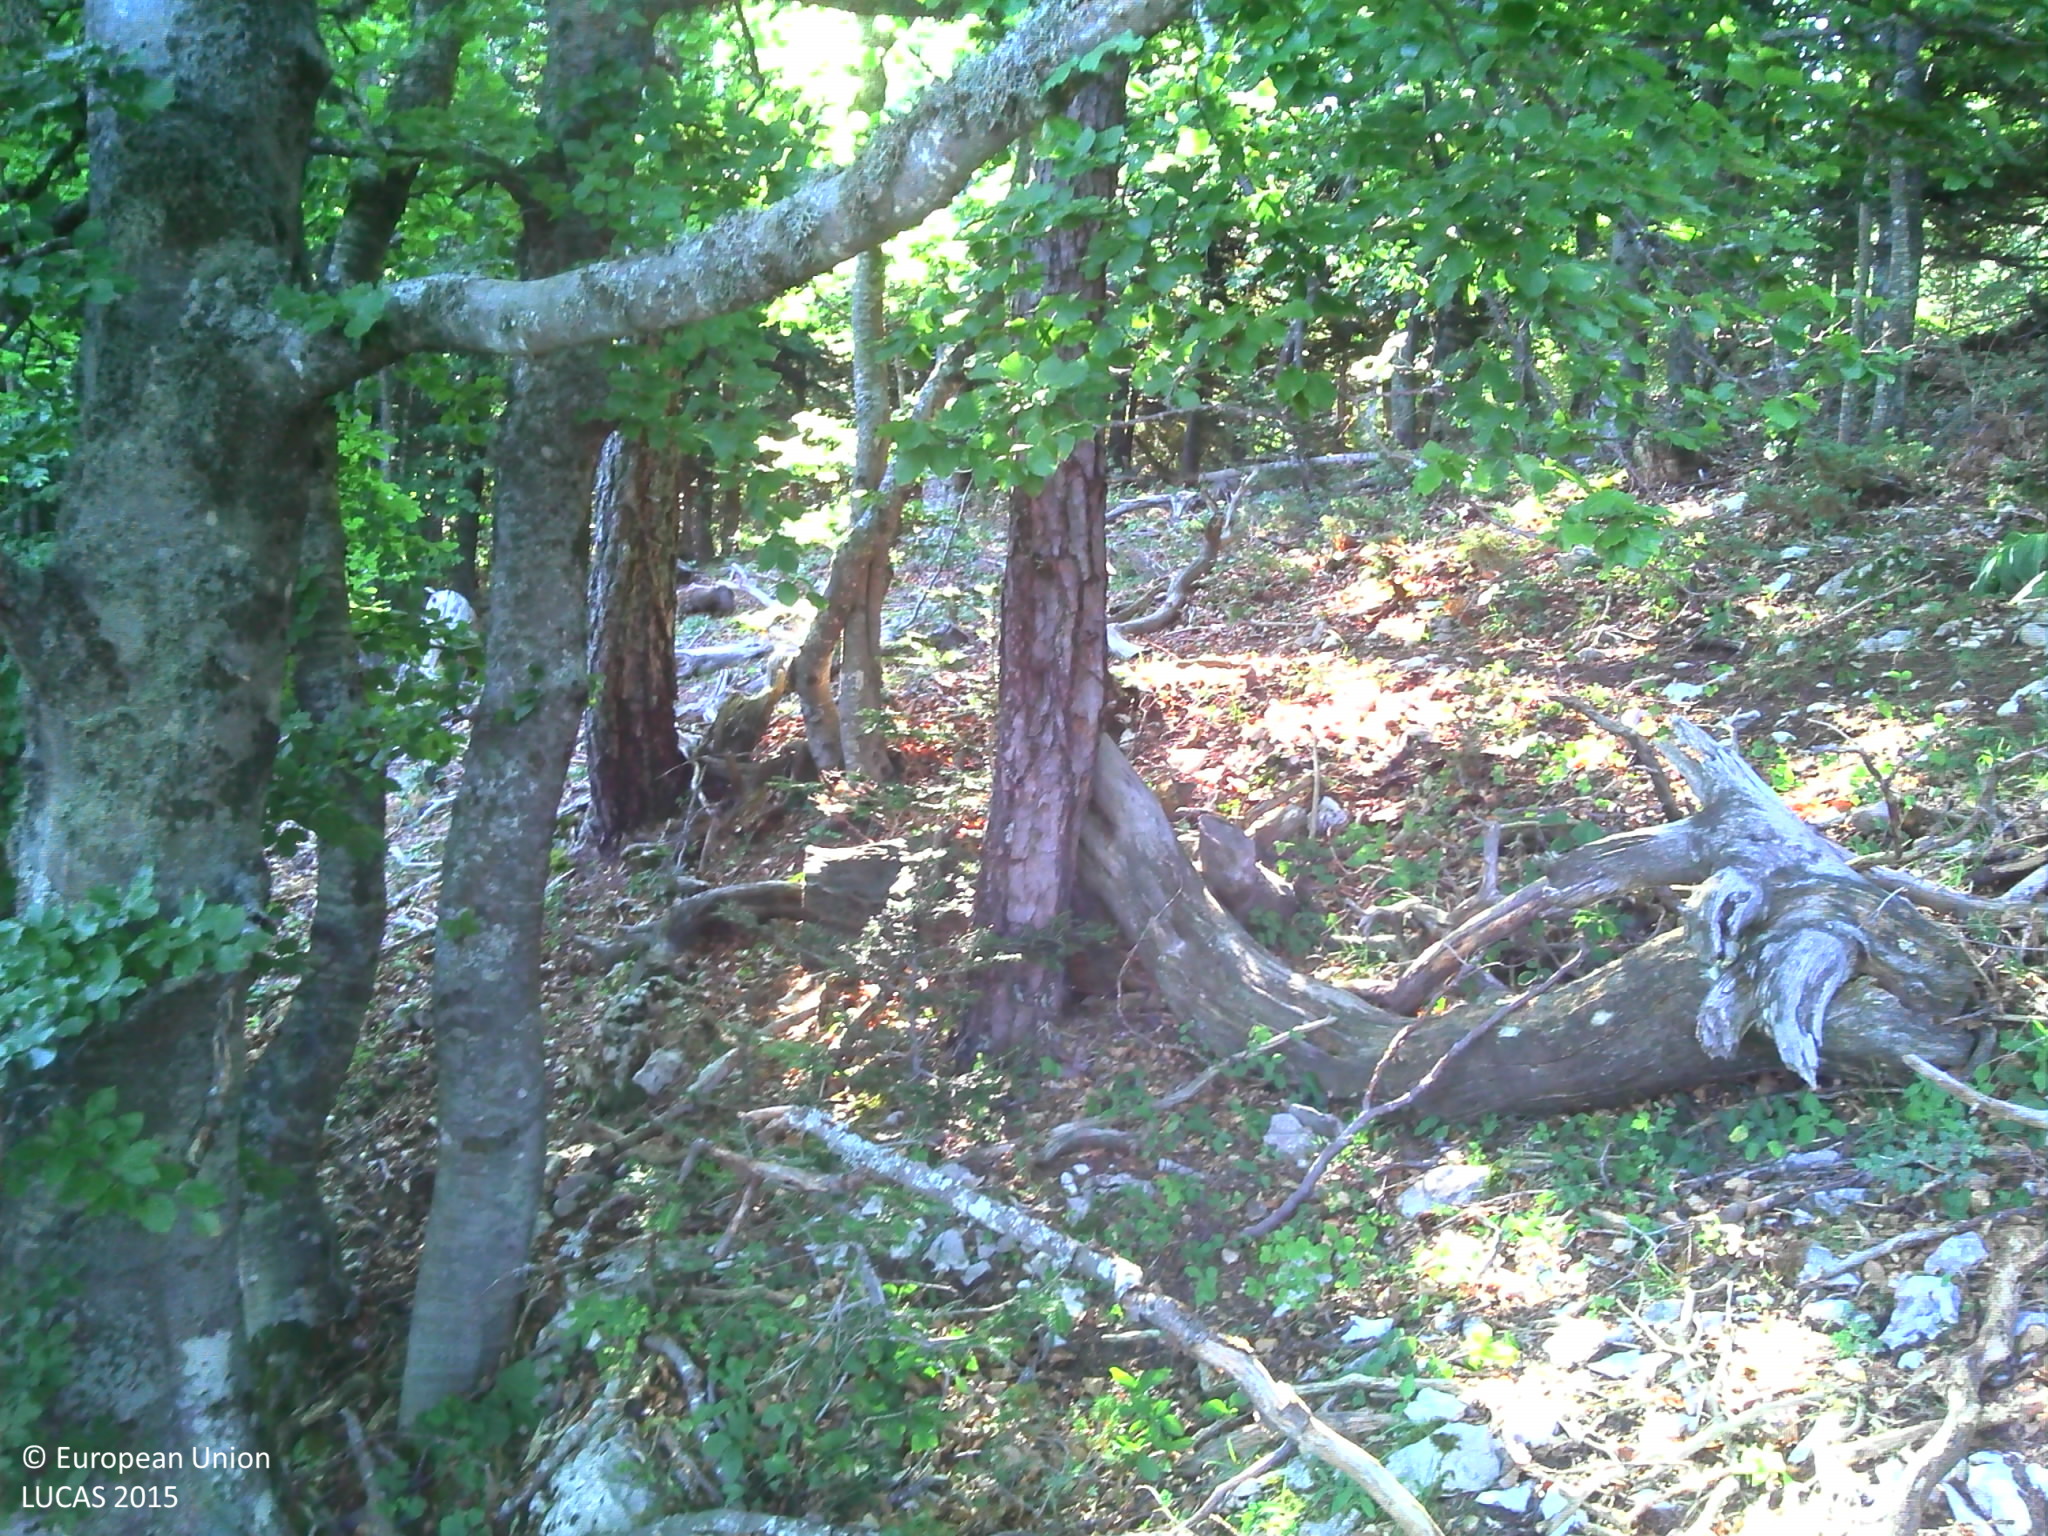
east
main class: Woodland
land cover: Pine dominated mixed woodland
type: coniferous forest of the mediterranean region
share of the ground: > 75 %
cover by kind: coniferous forest trees 30 %, lichens and mosses 20 %, unconsolidated bare surface 20 %, broadleaved forest trees 15 %, consolidated bare surface 10 %, shrubs 5 %
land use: Forestry
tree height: > 5 m
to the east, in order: Pine dominated mixed woodland; Other coniferous woodland; Pine dominated mixed woodland
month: July
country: FR
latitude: 44.1884
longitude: 5.2664
